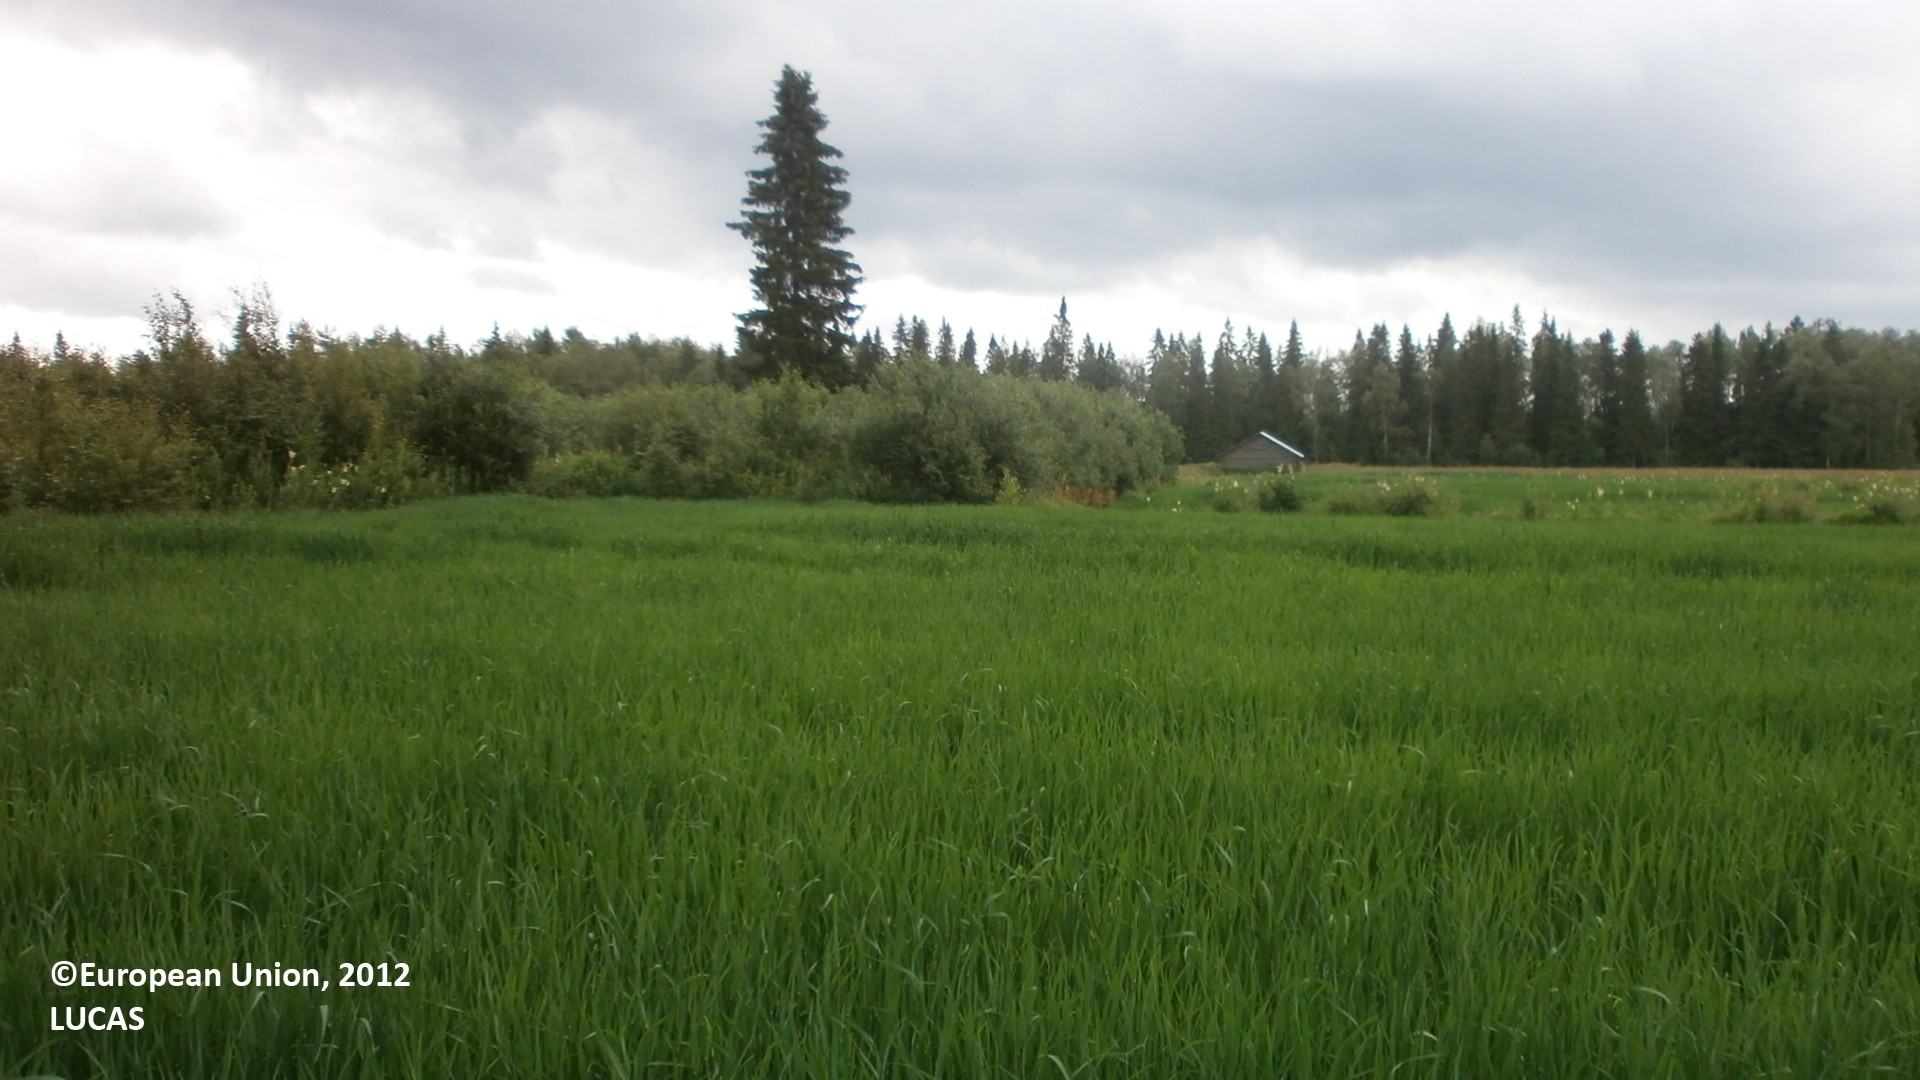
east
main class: Cropland
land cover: Oats
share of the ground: > 75 %
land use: Agriculture (excluding fallow land and kitchen gardens)
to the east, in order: Oats; Shruby margins; Ditches and canals; Shrubland with sparse tree cover; Broadleaved woodland; Grassland with sparse tree/shrub cover; Broadleaved woodland; Ditches and canals; Shruby margins; Temporary grasslands; Shruby margins; Ditches and canals; Shruby margins; Temporary grasslands; Shruby margins; Ditches and canals; Temporary grasslands; Ditches and canals; Shruby margins; Temporary grasslands; Shruby margins; Ditches and canals; Spruce dominated coniferous woodland; Spruce dominated mixed woodland; Ditches and canals; Spruce dominated mixed woodland; Spruce dominated coniferous woodland
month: July
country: FI
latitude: 64.6212
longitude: 24.6029
